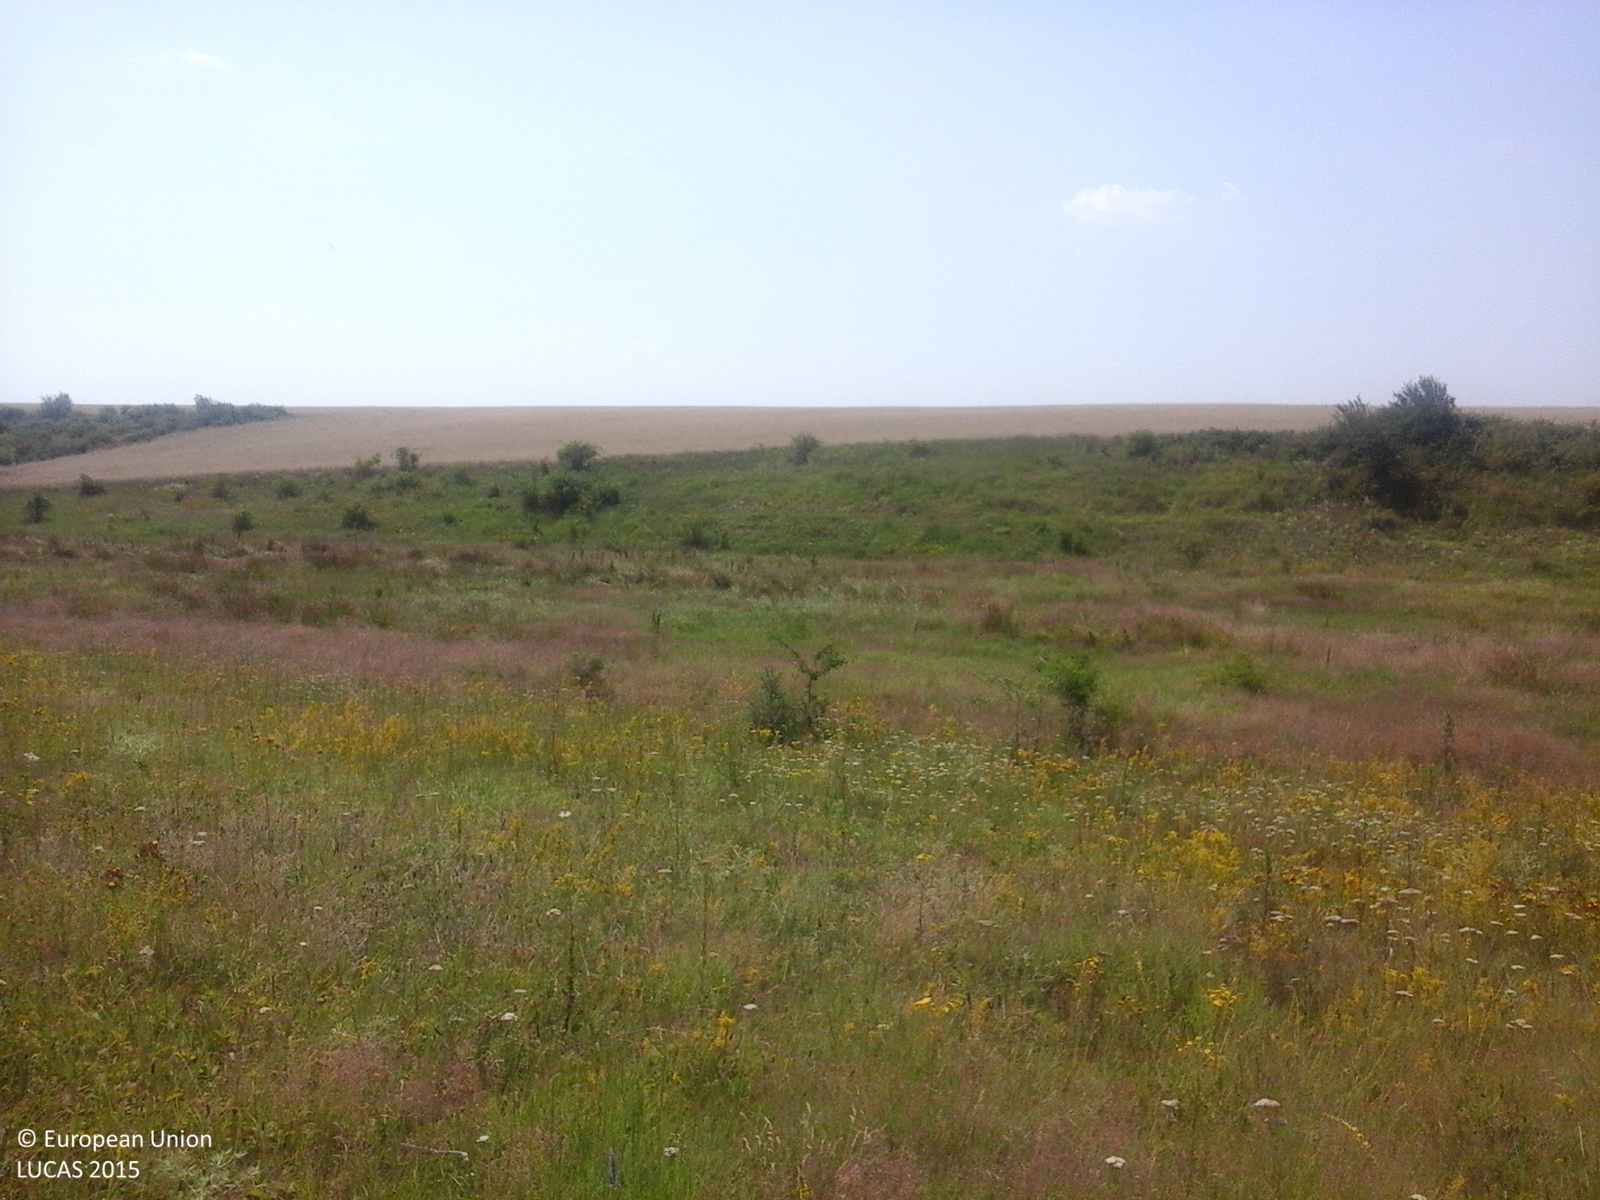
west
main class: Grassland
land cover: Grassland with sparse tree/shrub cover
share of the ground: > 75 %
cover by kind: herbaceous plants 85 %, shrubs 10 %, broadleaved forest trees 5 %
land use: Agriculture (excluding fallow land and kitchen gardens)
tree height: < 5 m
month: July
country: RO
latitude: 44.7127
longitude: 24.5268
